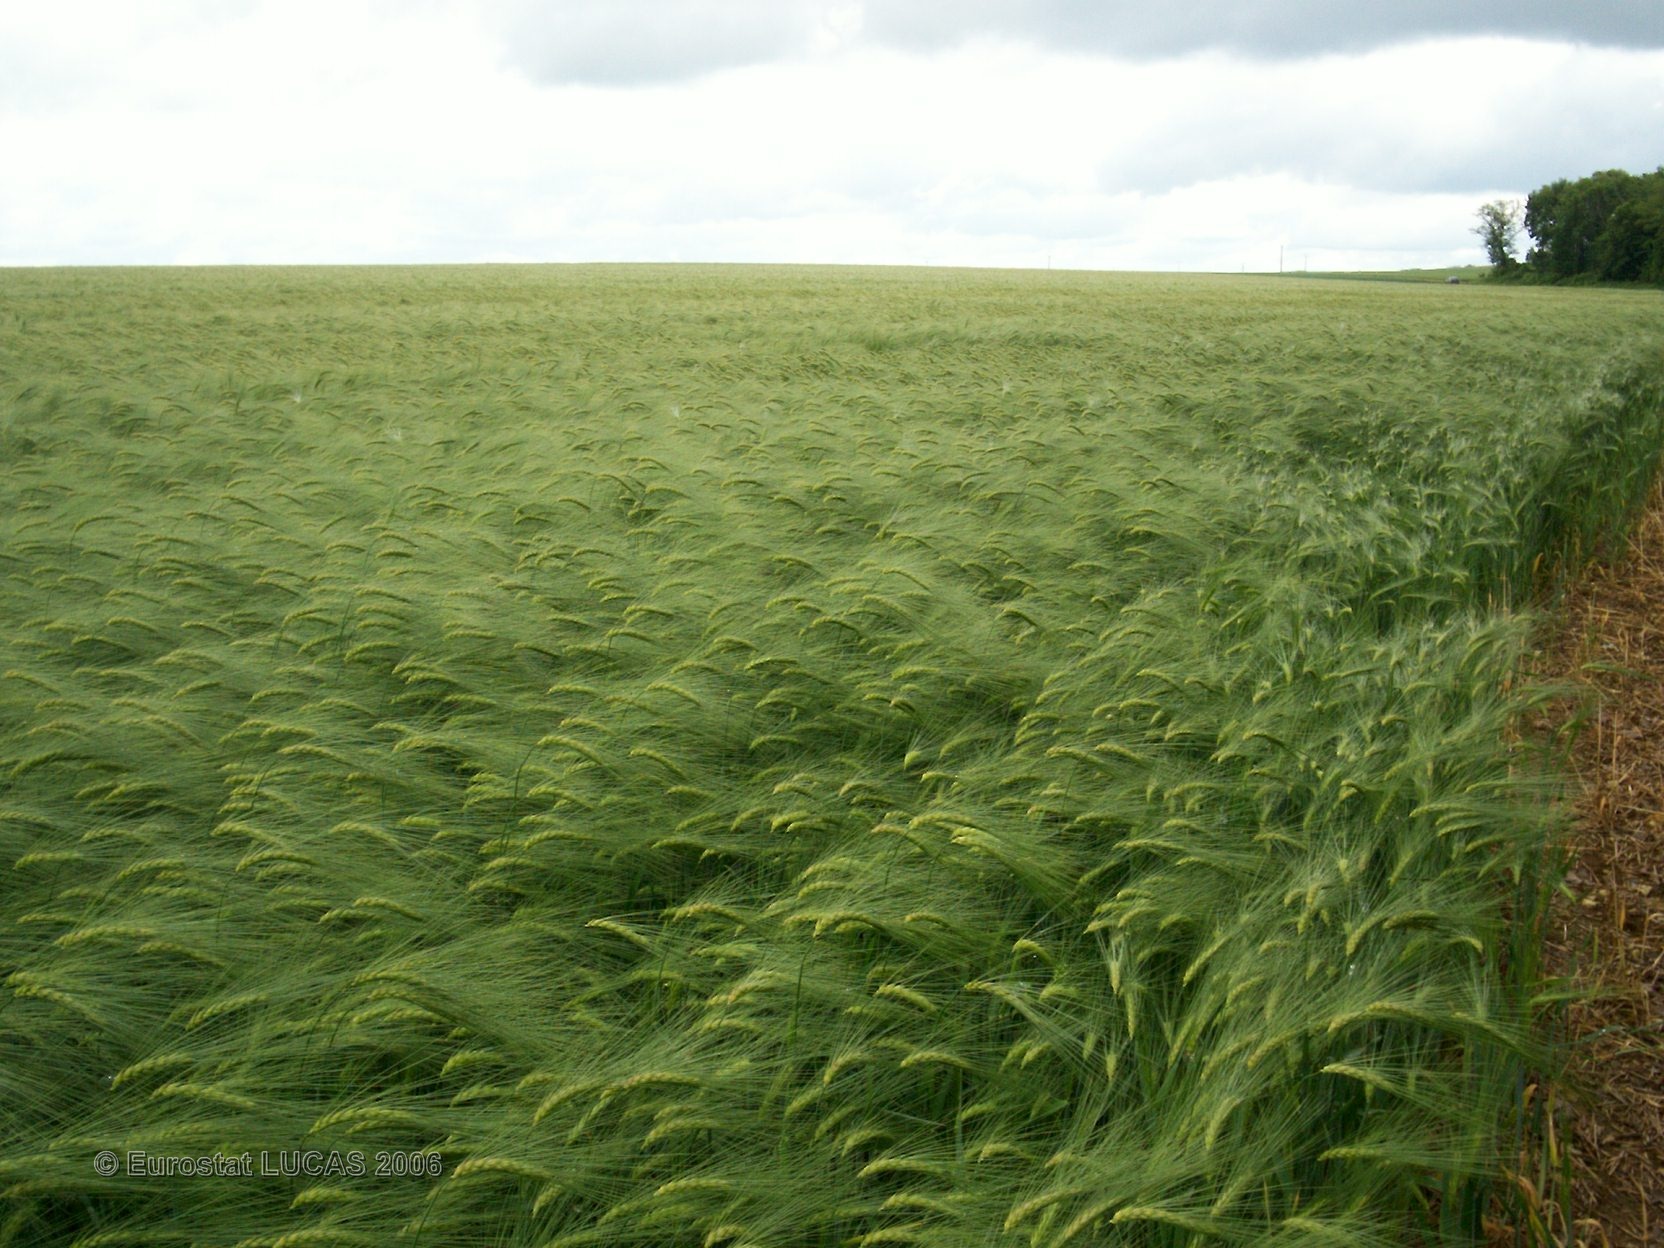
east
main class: Cropland
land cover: Barley
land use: Agriculture (excluding fallow land and kitchen gardens)
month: May
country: FR
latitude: 48.2494
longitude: 4.5164
